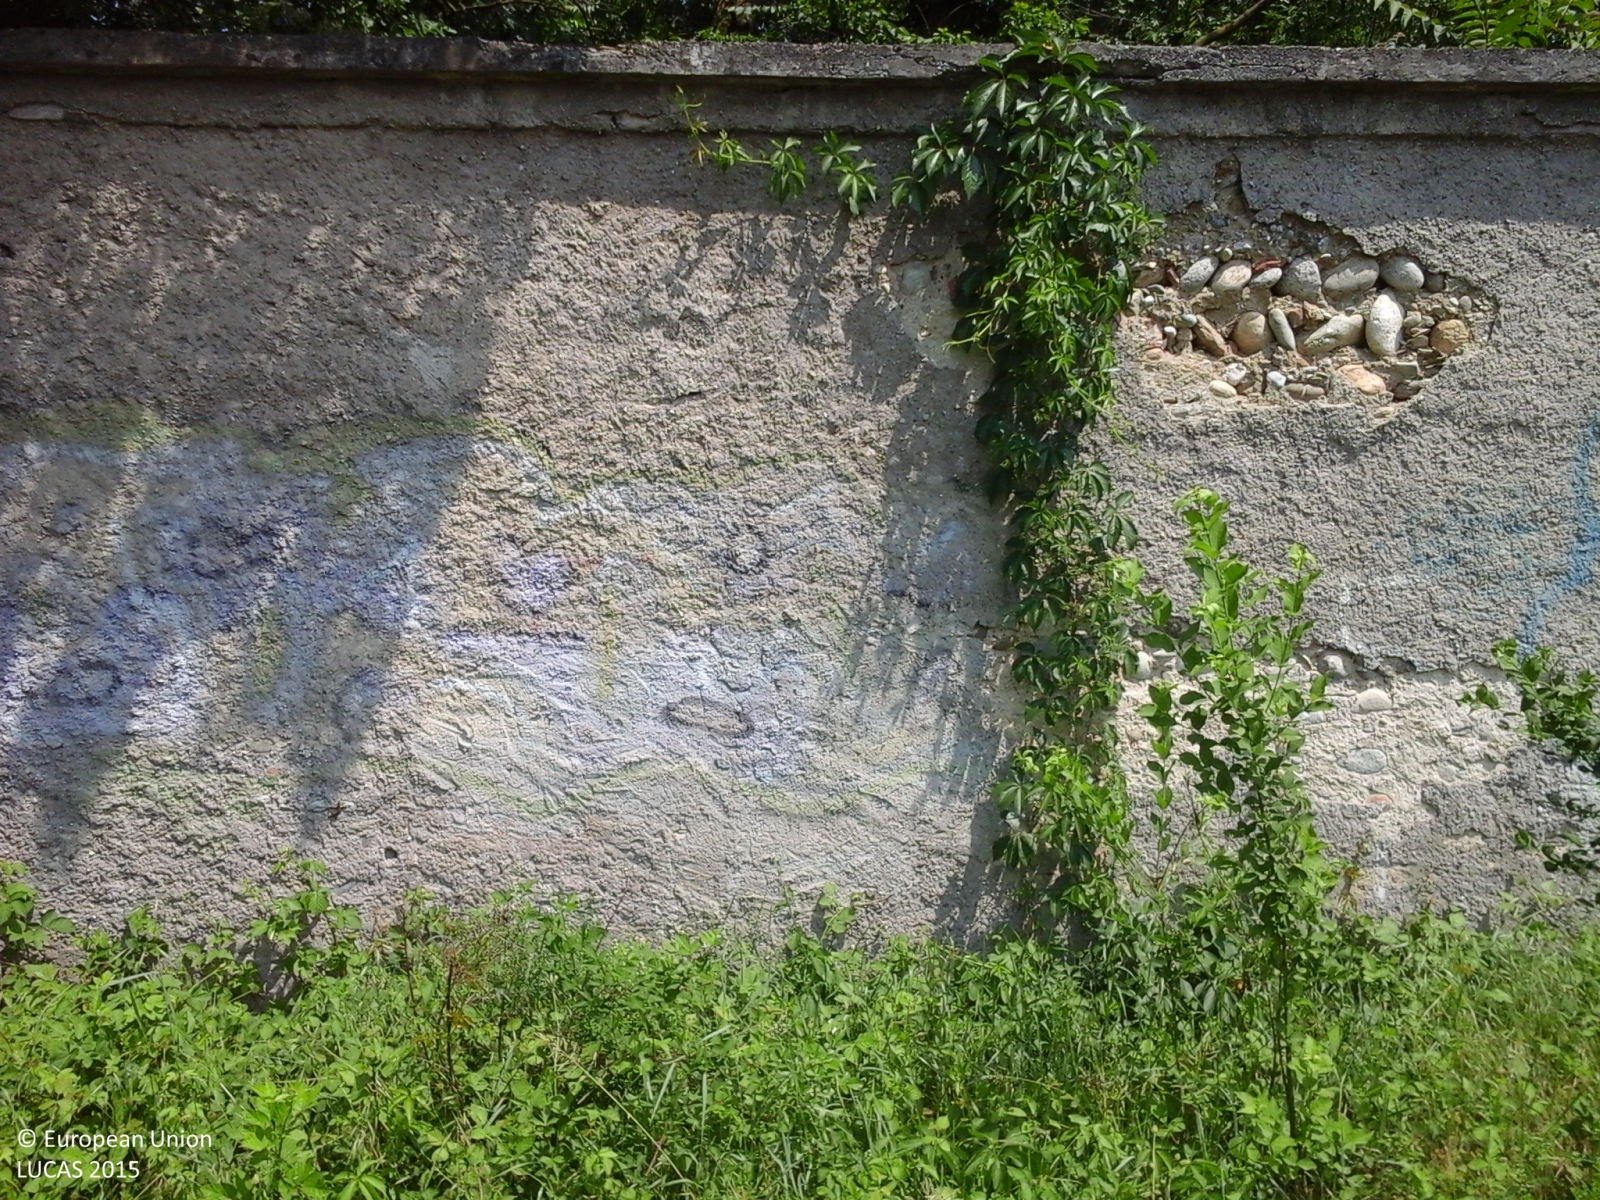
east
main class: Woodland
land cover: Broadleaved woodland
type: thermophilous deciduous forest
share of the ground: > 75 %
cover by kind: broadleaved forest trees 100 %
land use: Amenities, museums, leisure
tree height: > 5 m
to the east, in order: Broadleaved woodland
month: May
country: IT
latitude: 45.5934
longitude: 9.5265
